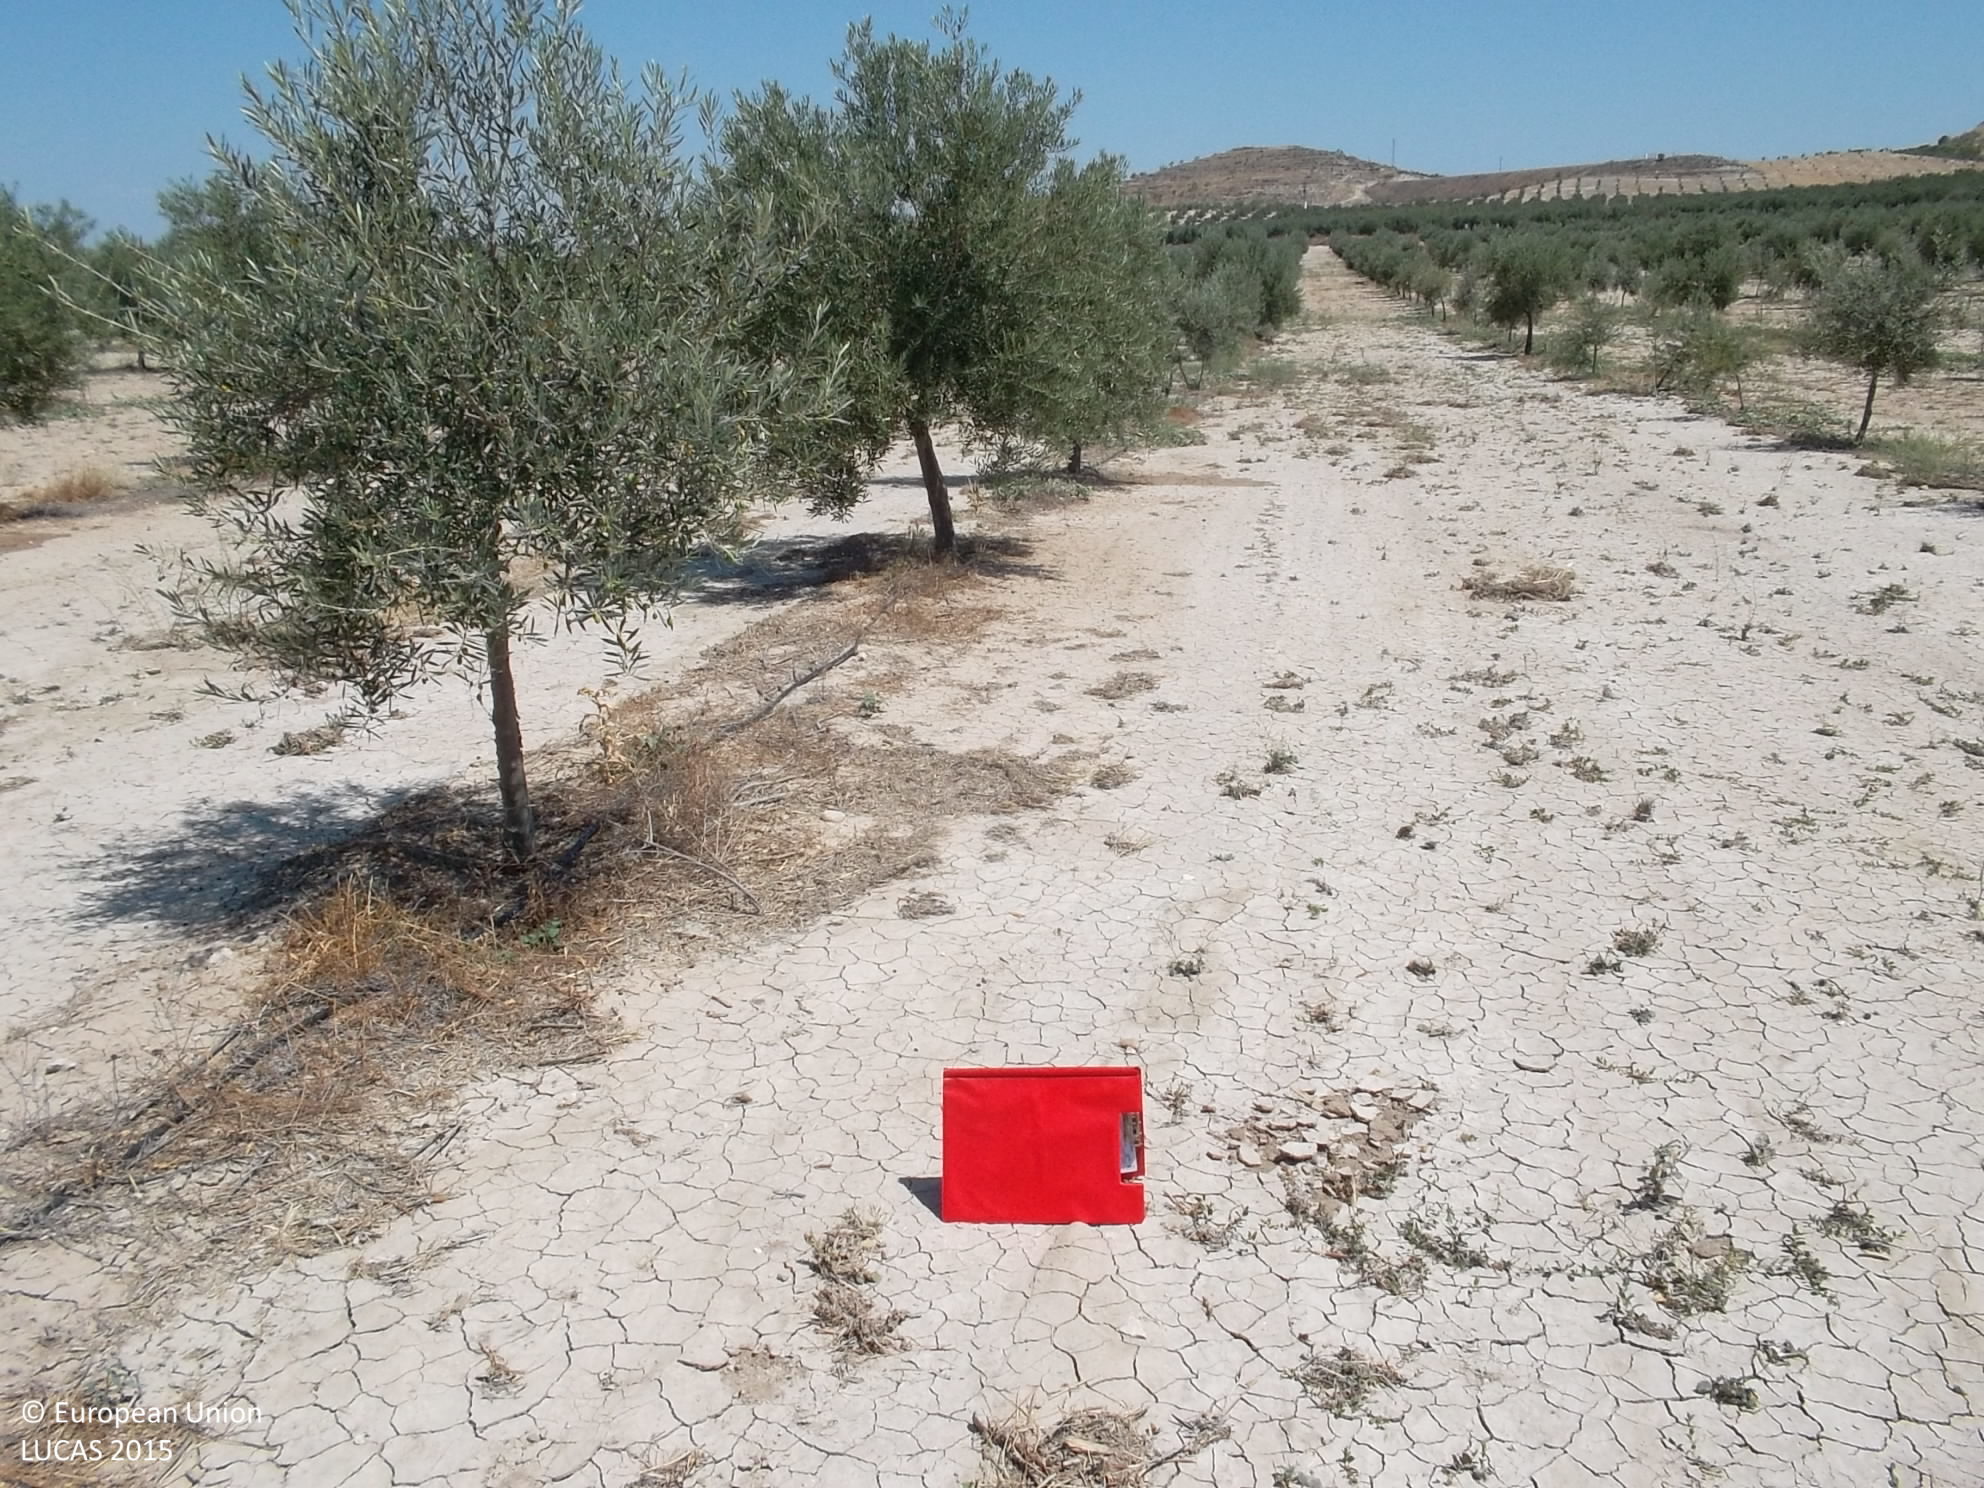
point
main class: Cropland
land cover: Olive groves
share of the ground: 25 - 50 %
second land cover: Other bare soil
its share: > 75 %
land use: Agriculture (excluding fallow land and kitchen gardens)
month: June
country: ES
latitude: 37.8454
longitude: -3.2354
